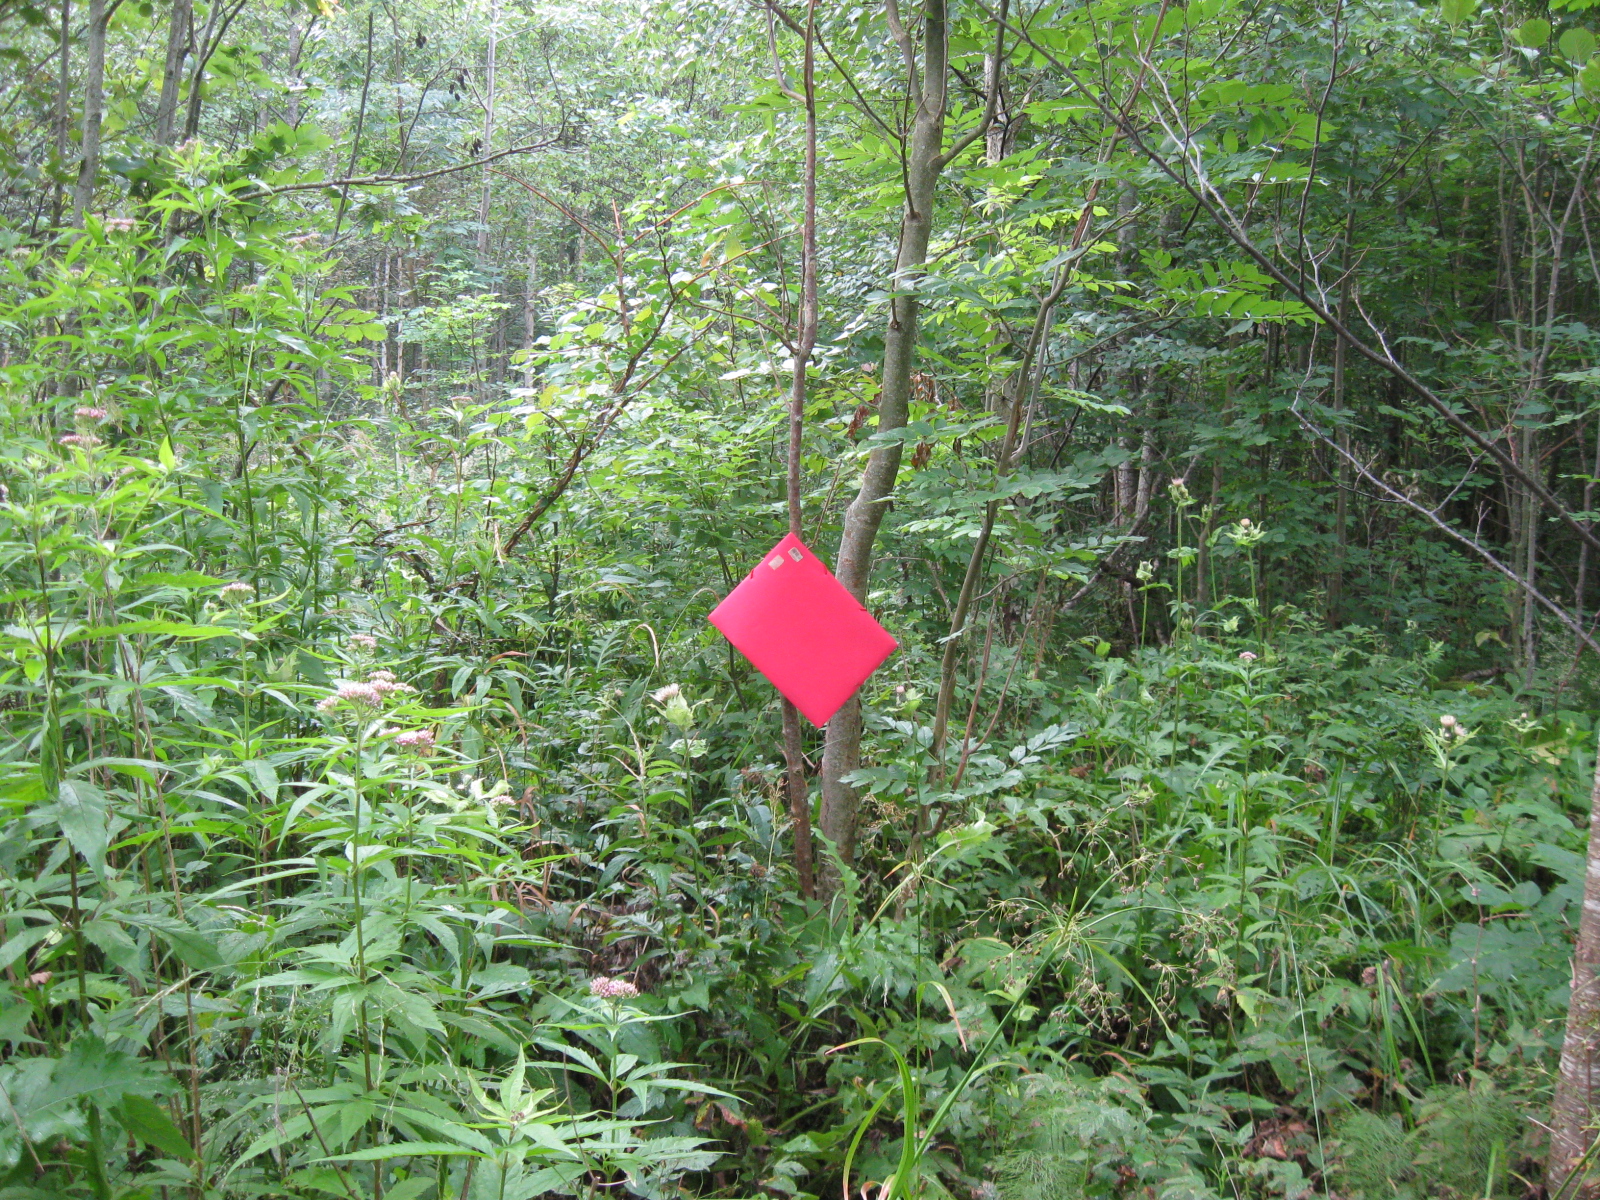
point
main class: Woodland
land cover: Broadleaved woodland
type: mire and swamp forests
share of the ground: > 75 %
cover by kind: broadleaved forest trees 75 %, herbaceous plants 25 %
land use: Forestry
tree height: > 5 m
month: July
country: LT
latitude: 54.4528
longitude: 23.4534
